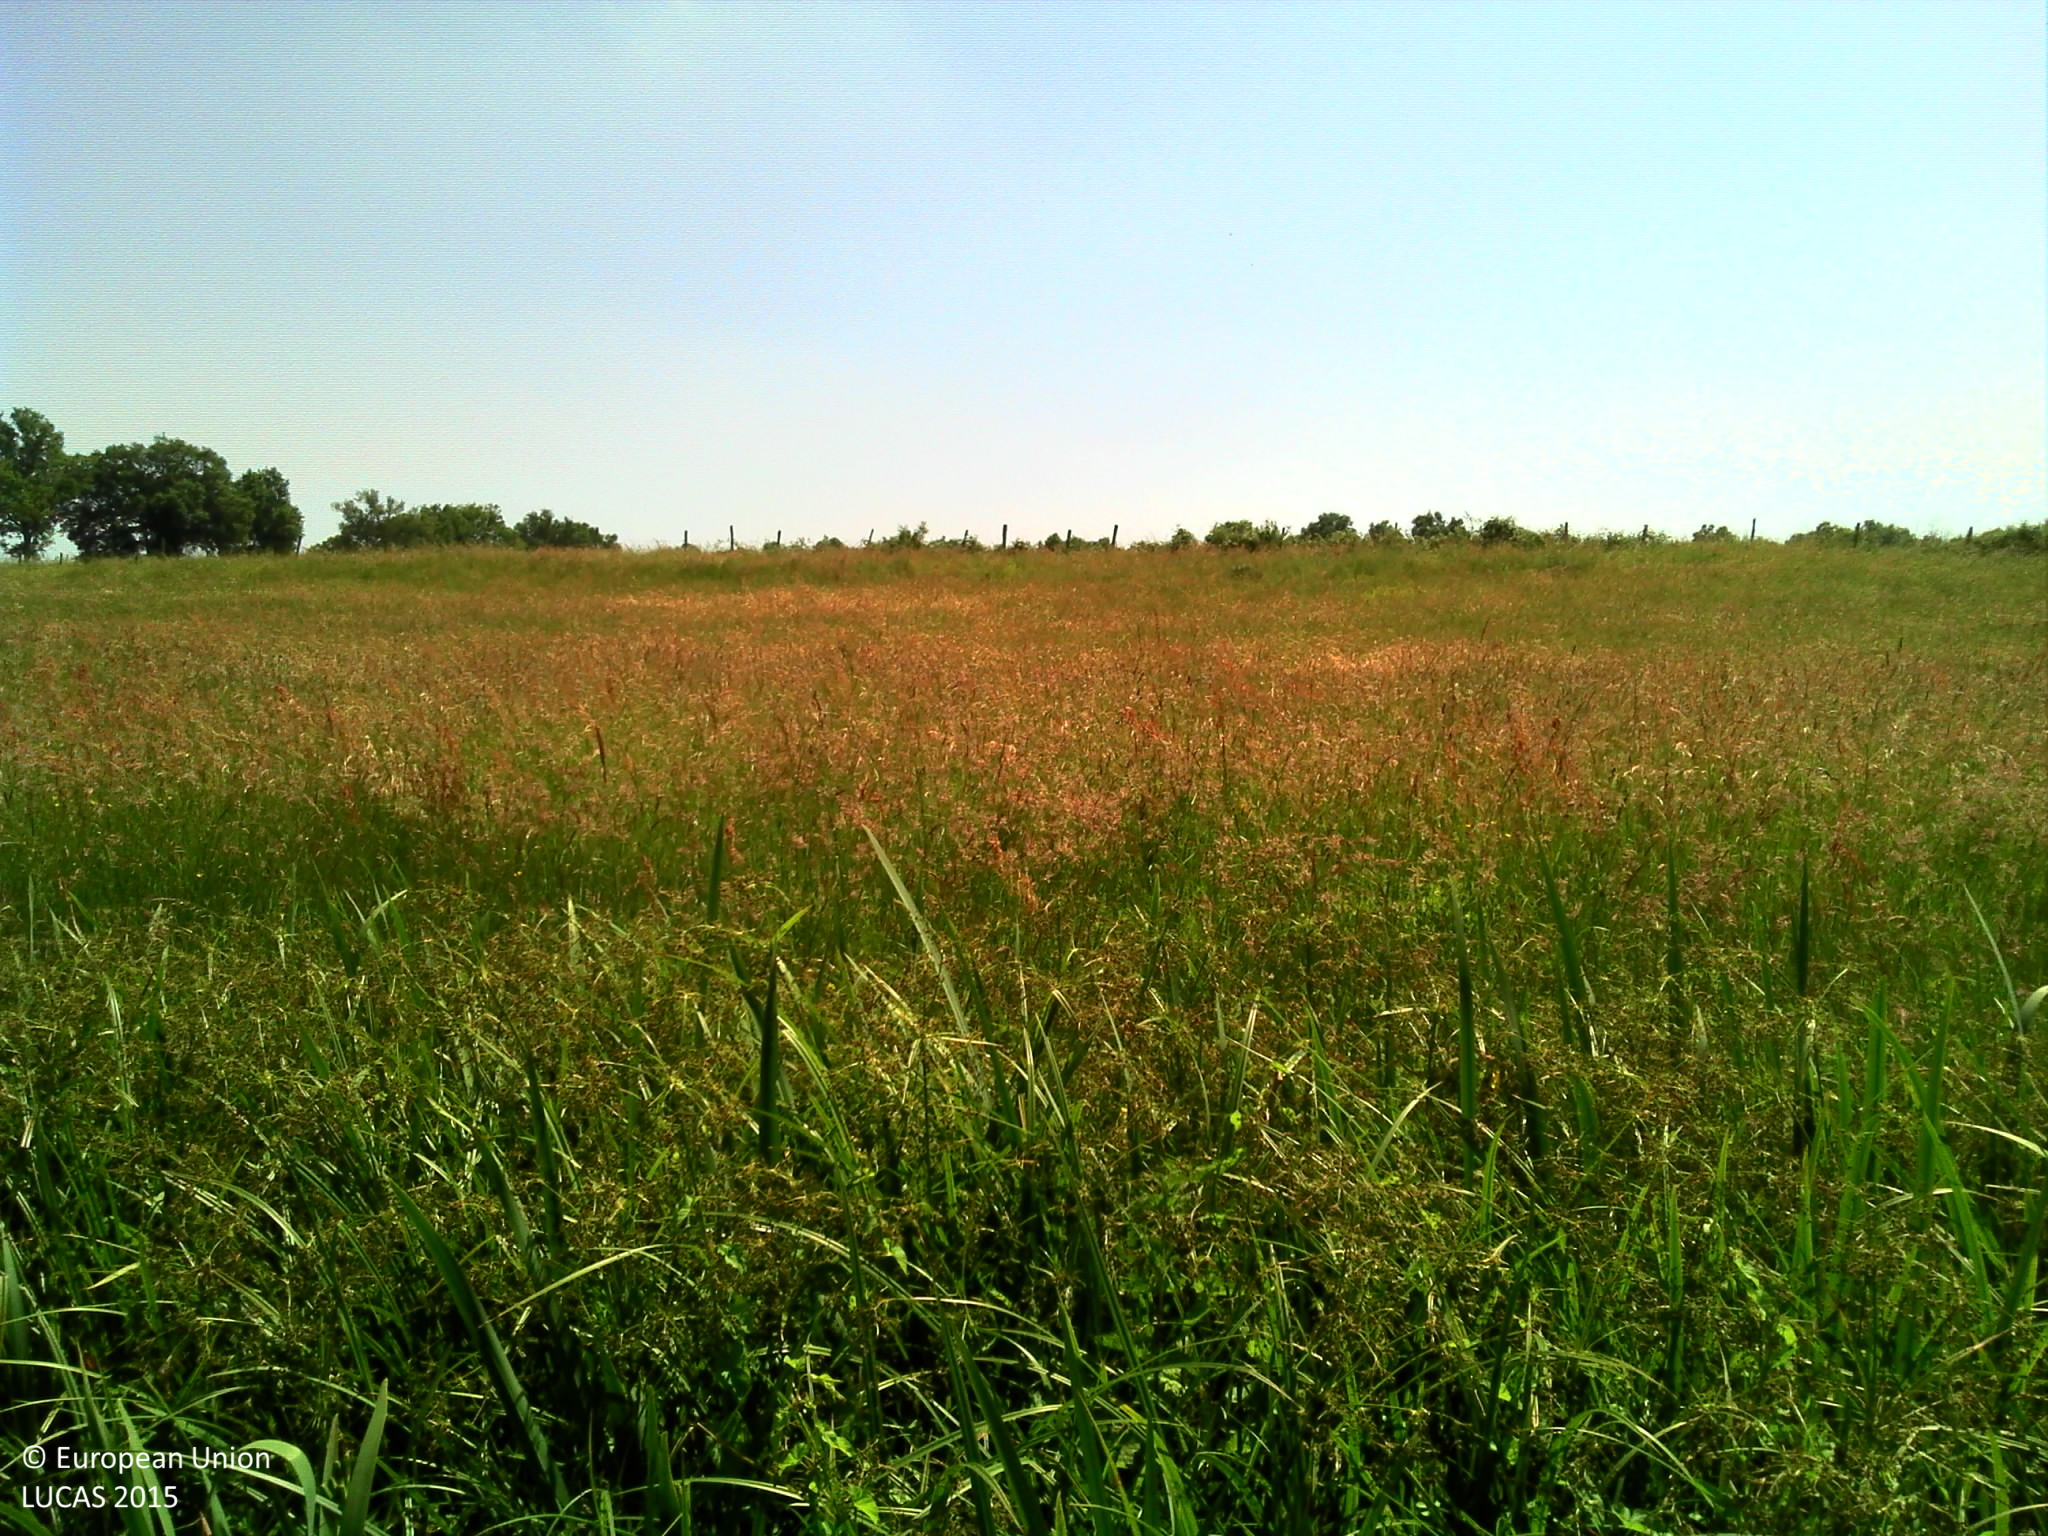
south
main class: Grassland
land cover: Spontaneously vegetated surfaces
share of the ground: > 75 %
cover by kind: herbaceous plants 95 %, shrubs 5 %
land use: Agriculture (excluding fallow land and kitchen gardens)
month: June
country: FR
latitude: 46.0577
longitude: 0.5359
